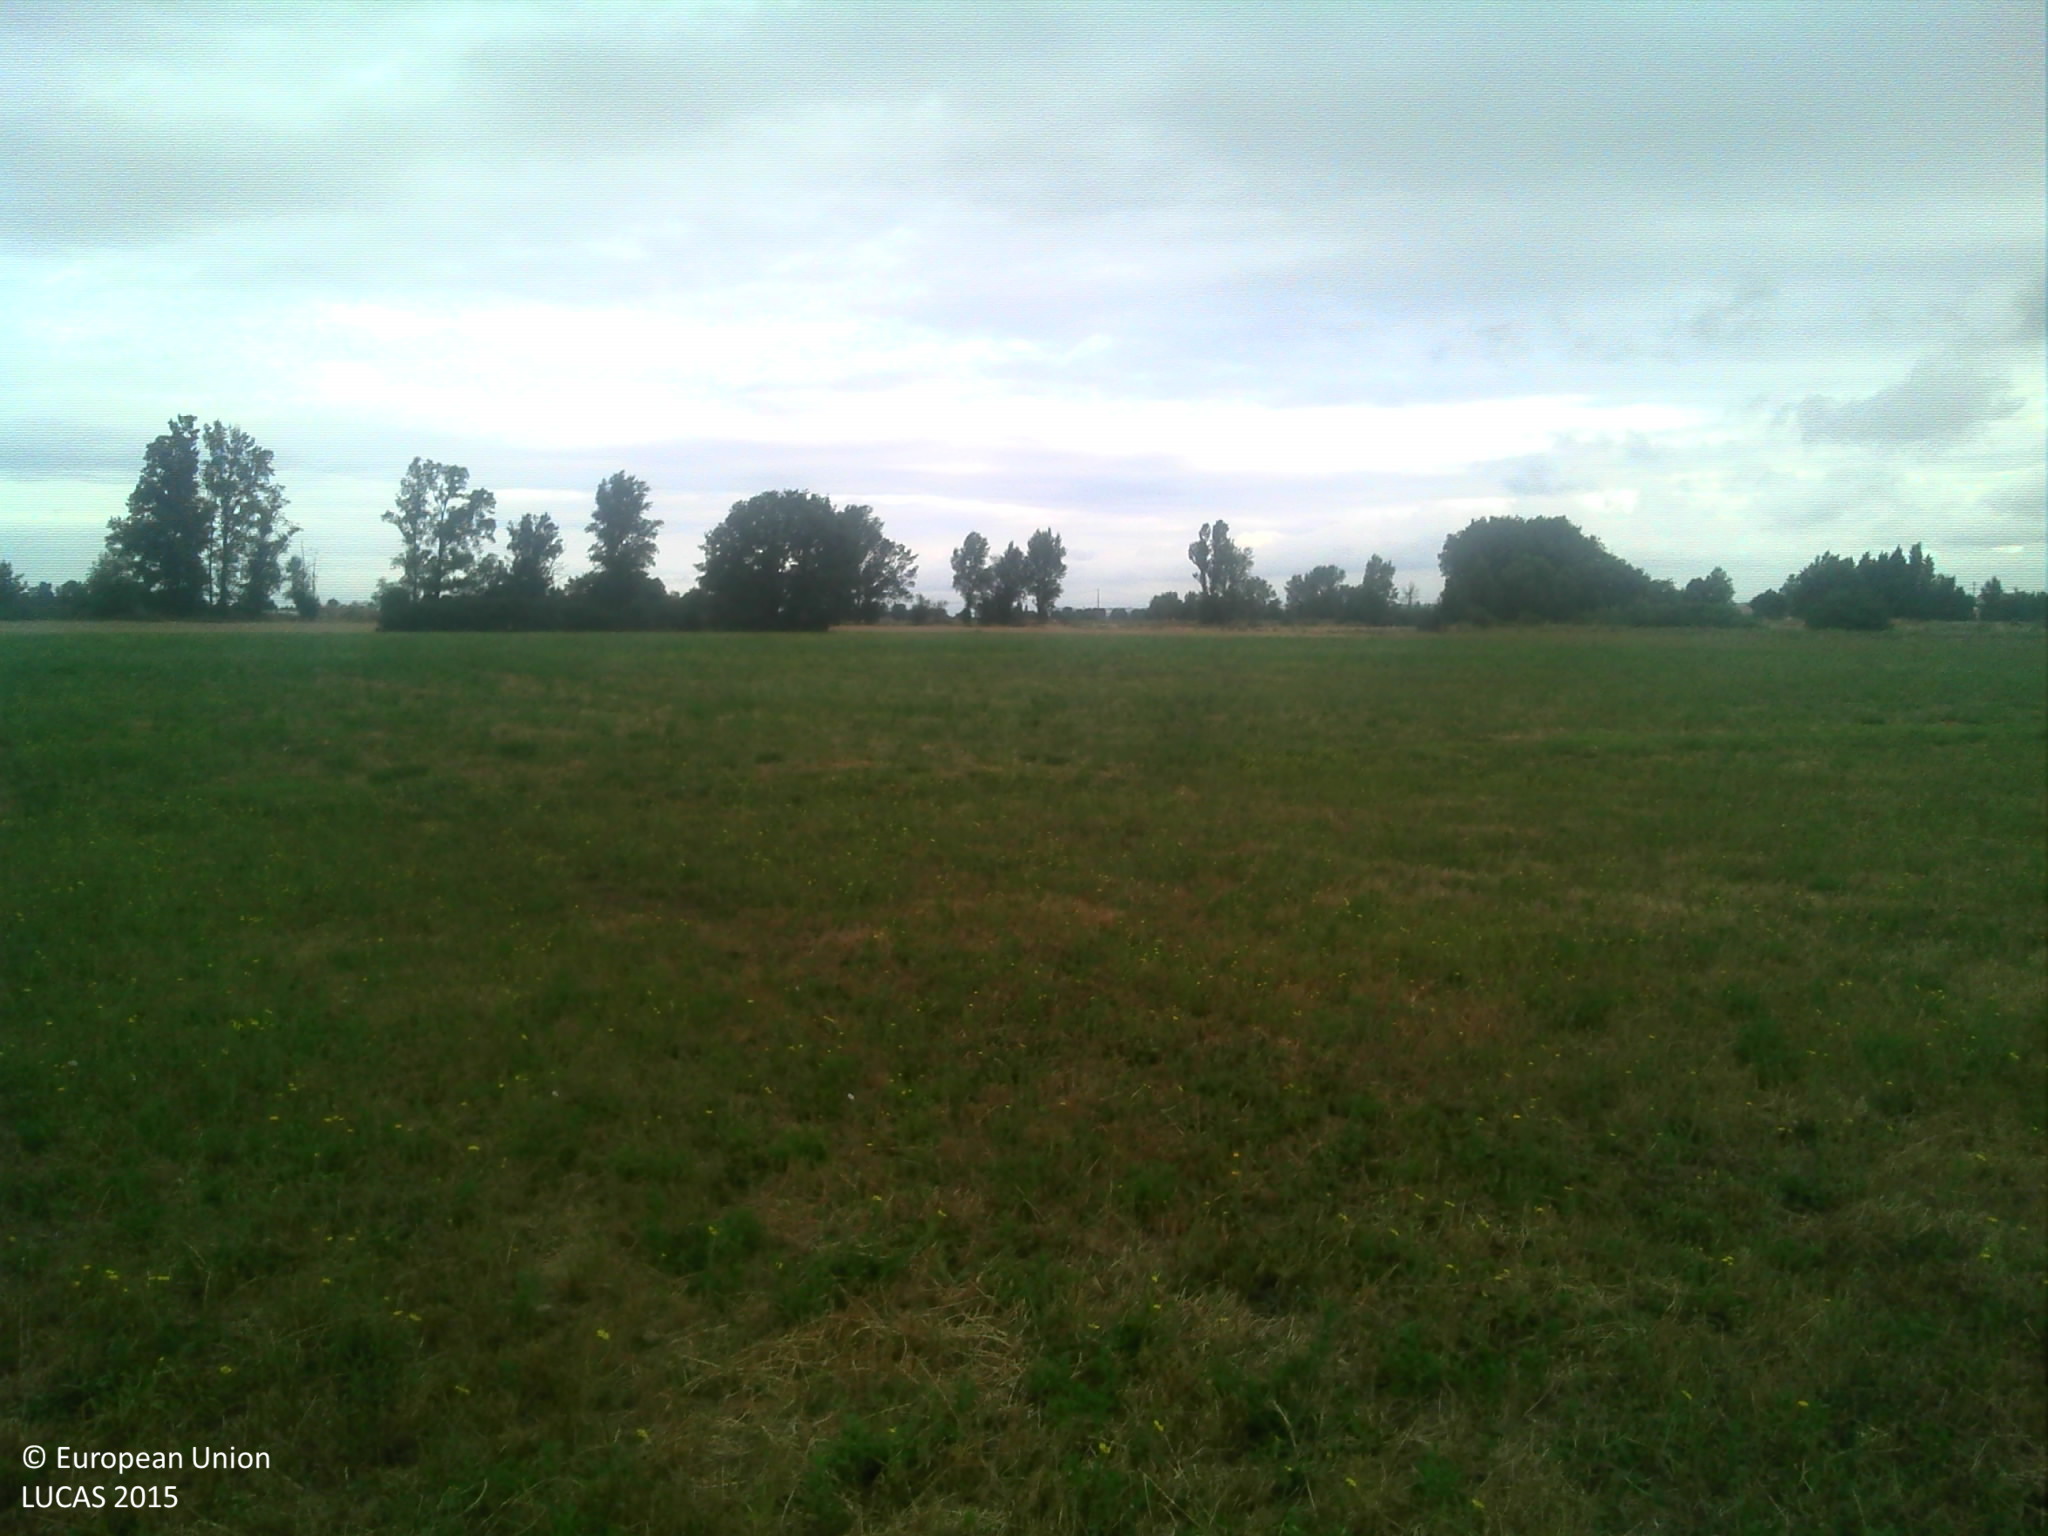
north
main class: Grassland
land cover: Grassland without tree/shrub cover
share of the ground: > 75 %
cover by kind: herbaceous plants 100 %
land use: Agriculture (excluding fallow land and kitchen gardens)
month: July
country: FR
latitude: 43.3607
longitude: 1.4282
